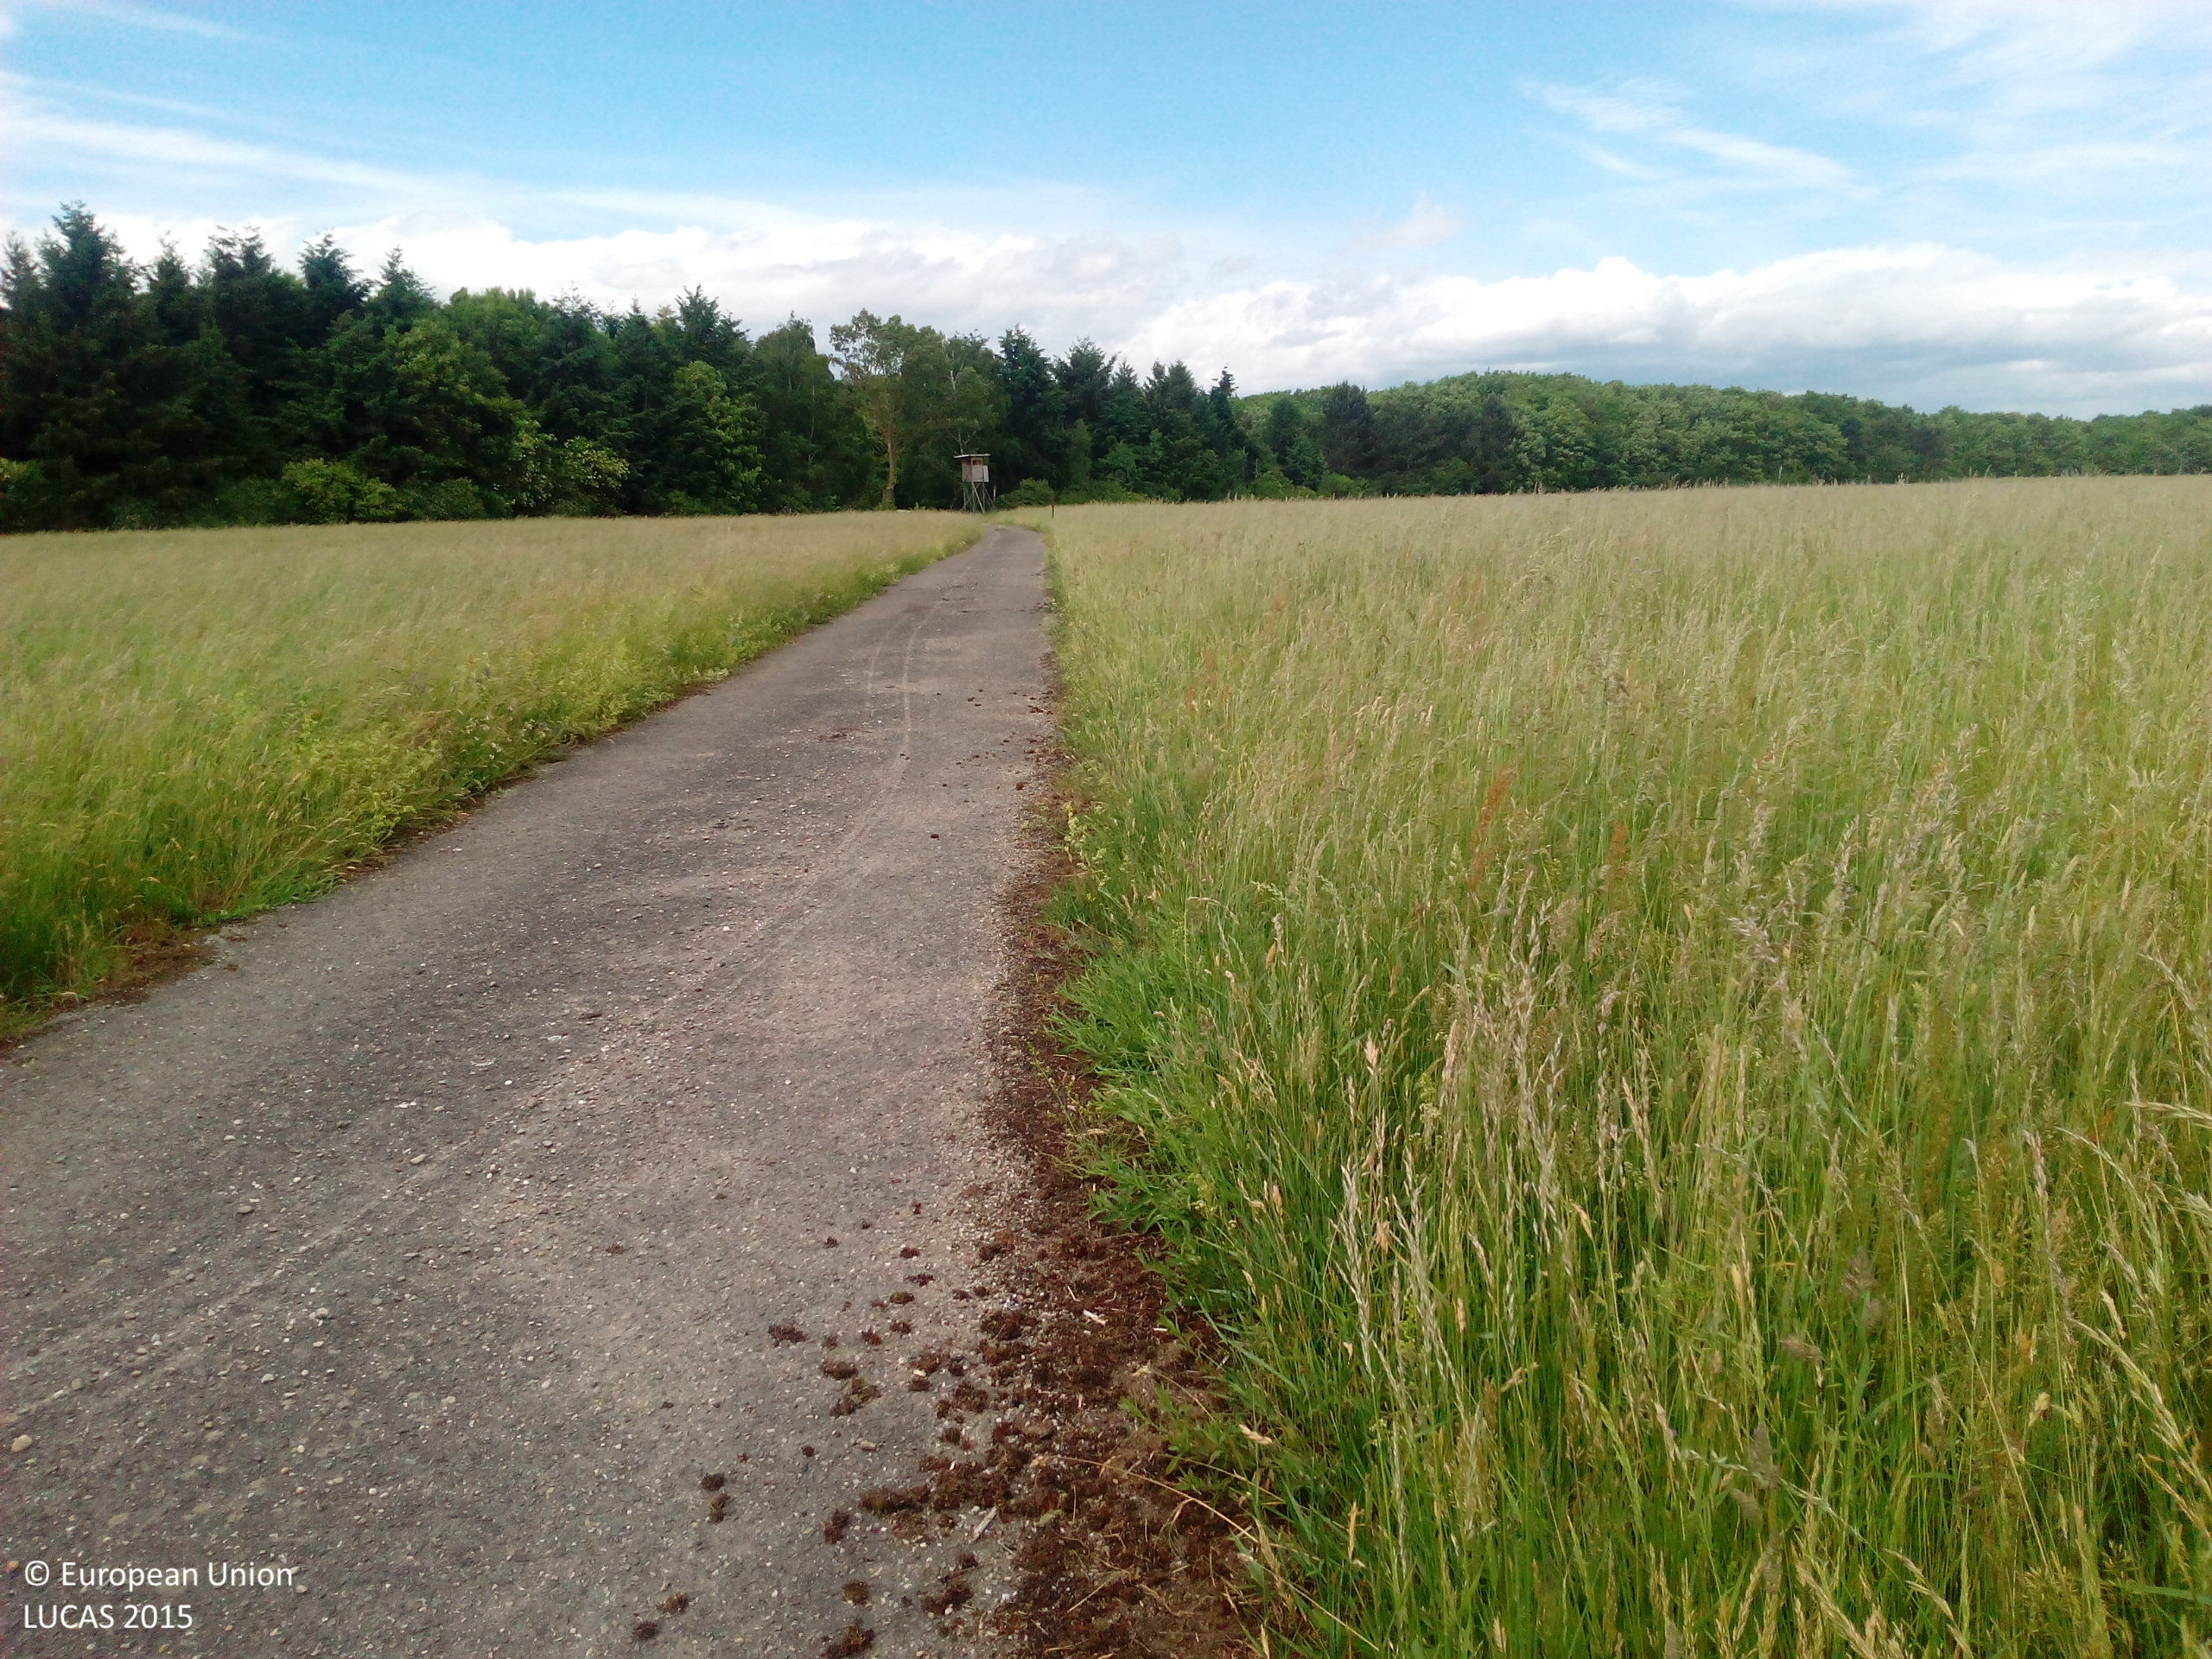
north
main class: Grassland
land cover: Grassland without tree/shrub cover
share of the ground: > 75 %
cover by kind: herbaceous plants 100 %
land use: Air transport
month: May
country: DE
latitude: 47.9101
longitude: 7.6331
